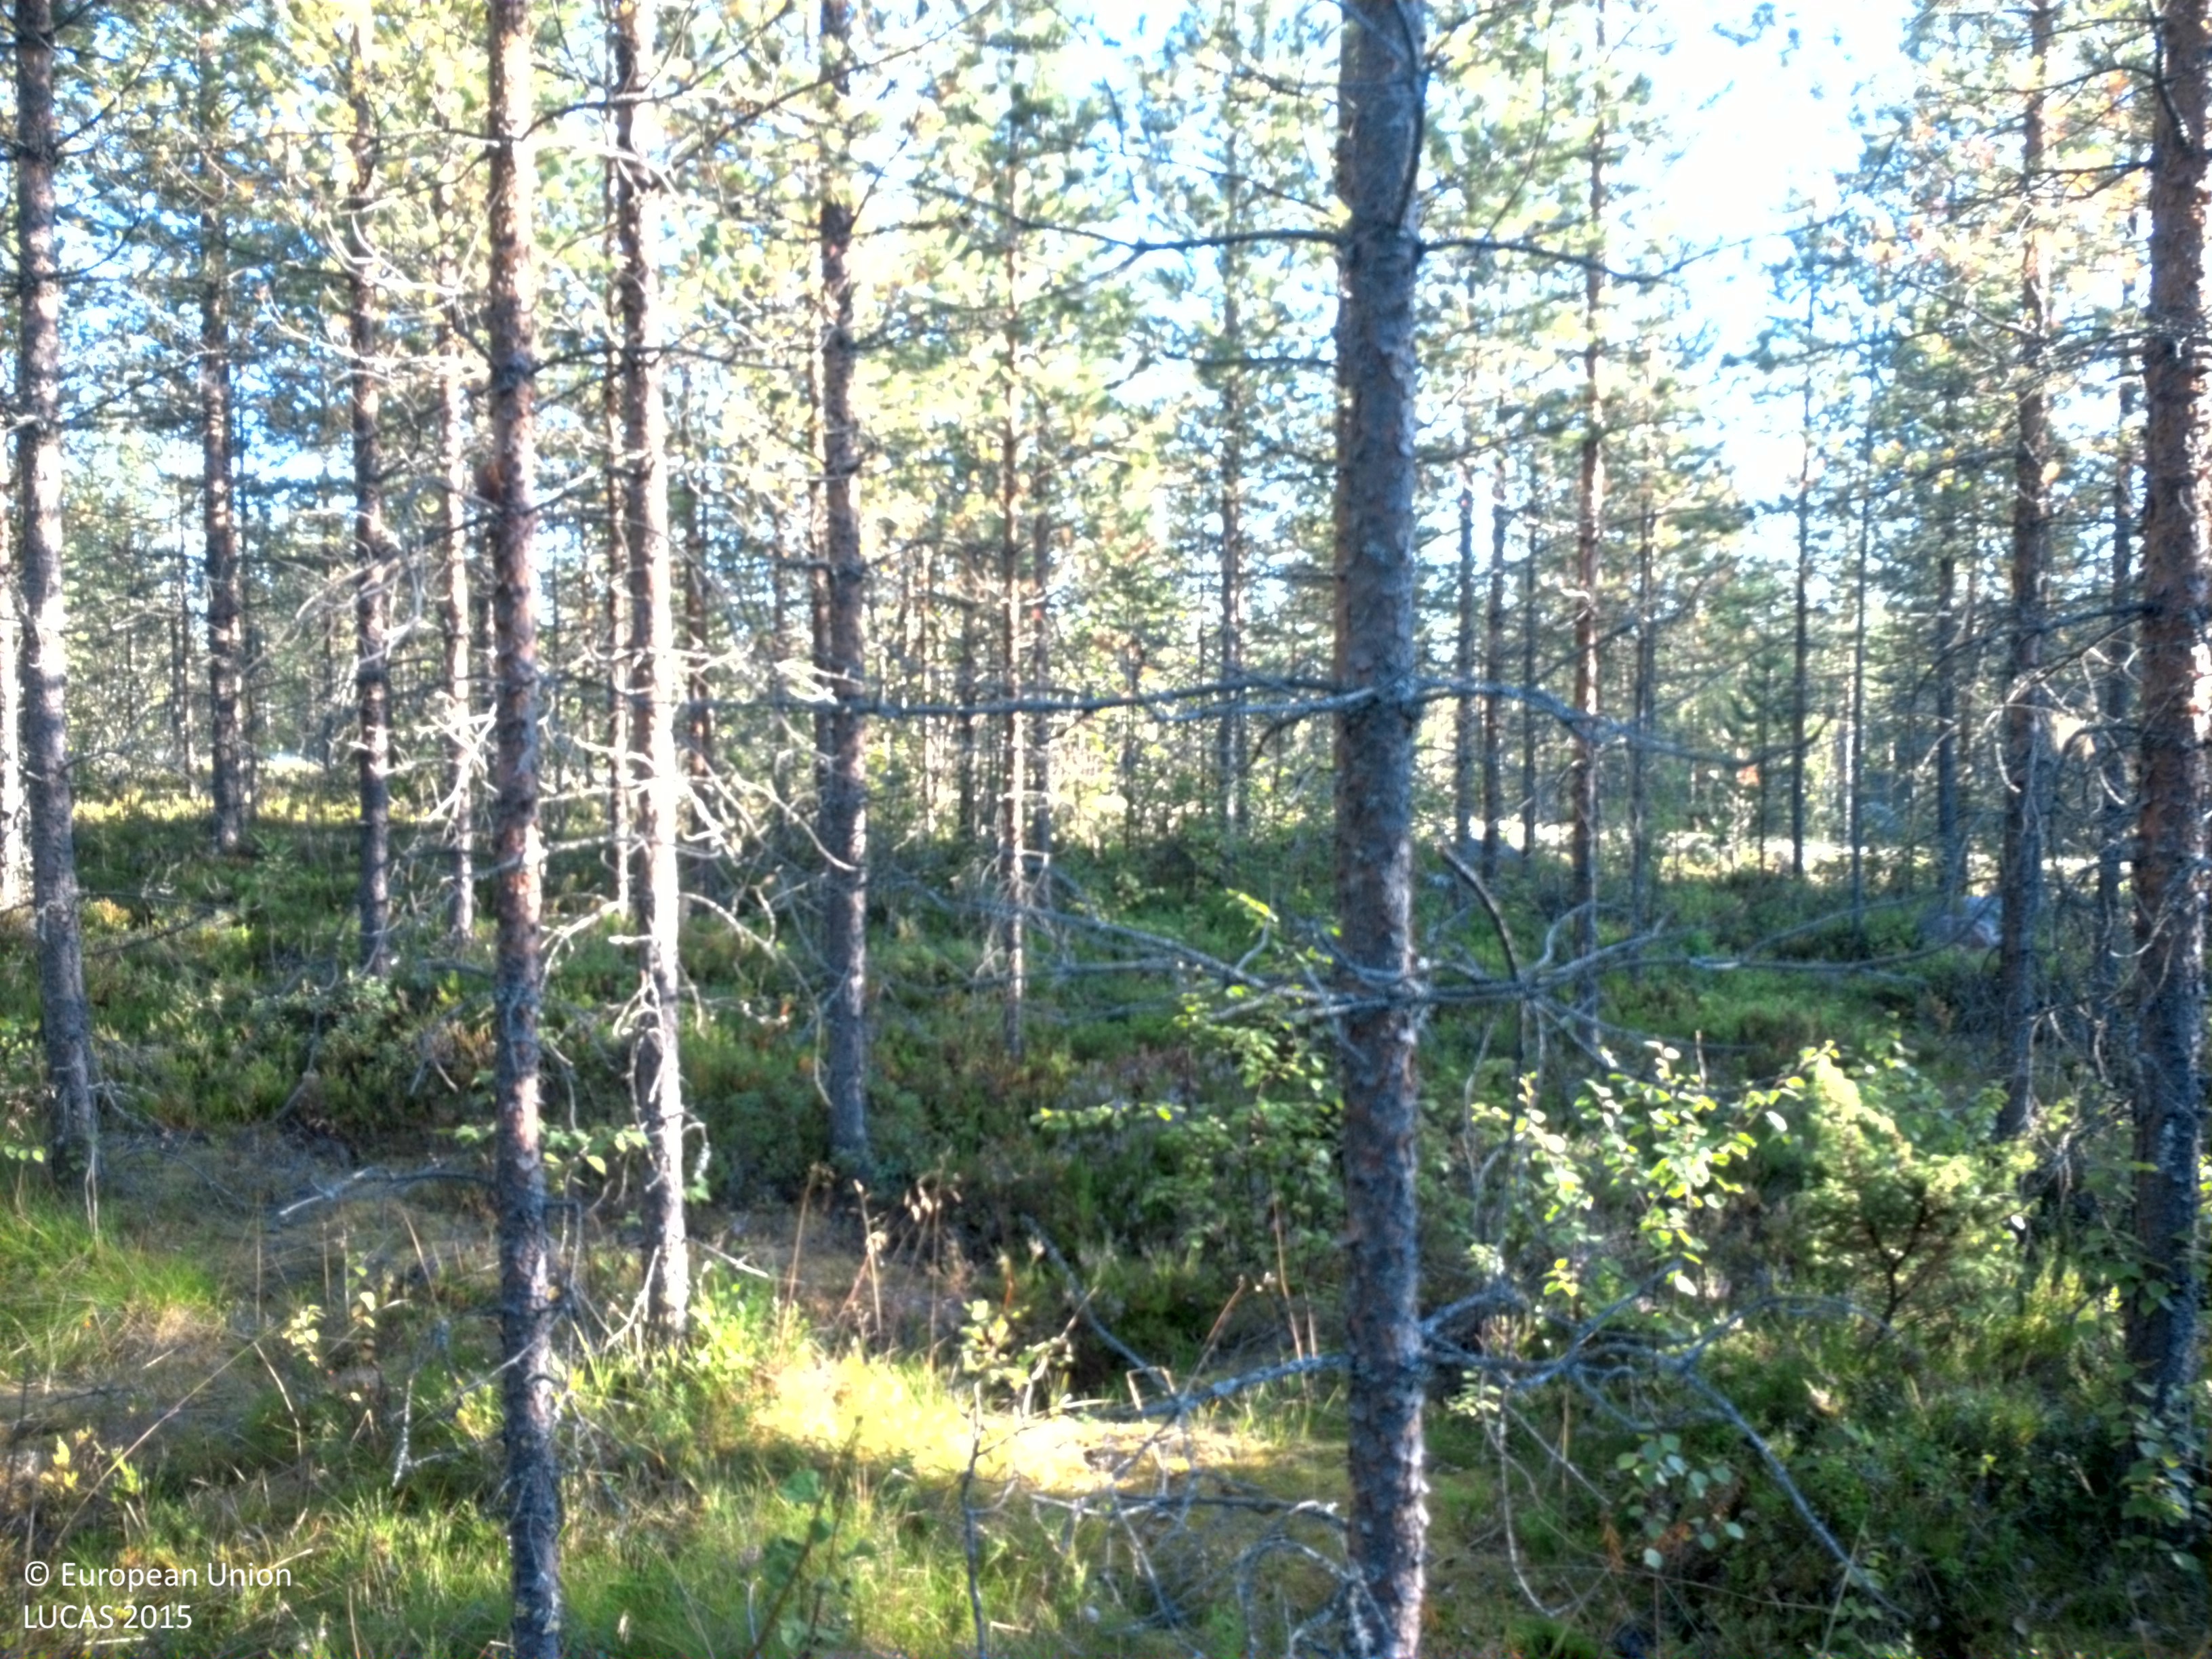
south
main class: Woodland
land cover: Pine dominated coniferous woodland
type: boreal forest
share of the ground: 50 - 75 %
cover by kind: coniferous forest trees 55 %, shrubs 40 %, broadleaved forest trees 5 %
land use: Forestry
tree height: > 5 m
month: August
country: SE
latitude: 64.3952
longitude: 19.0337
